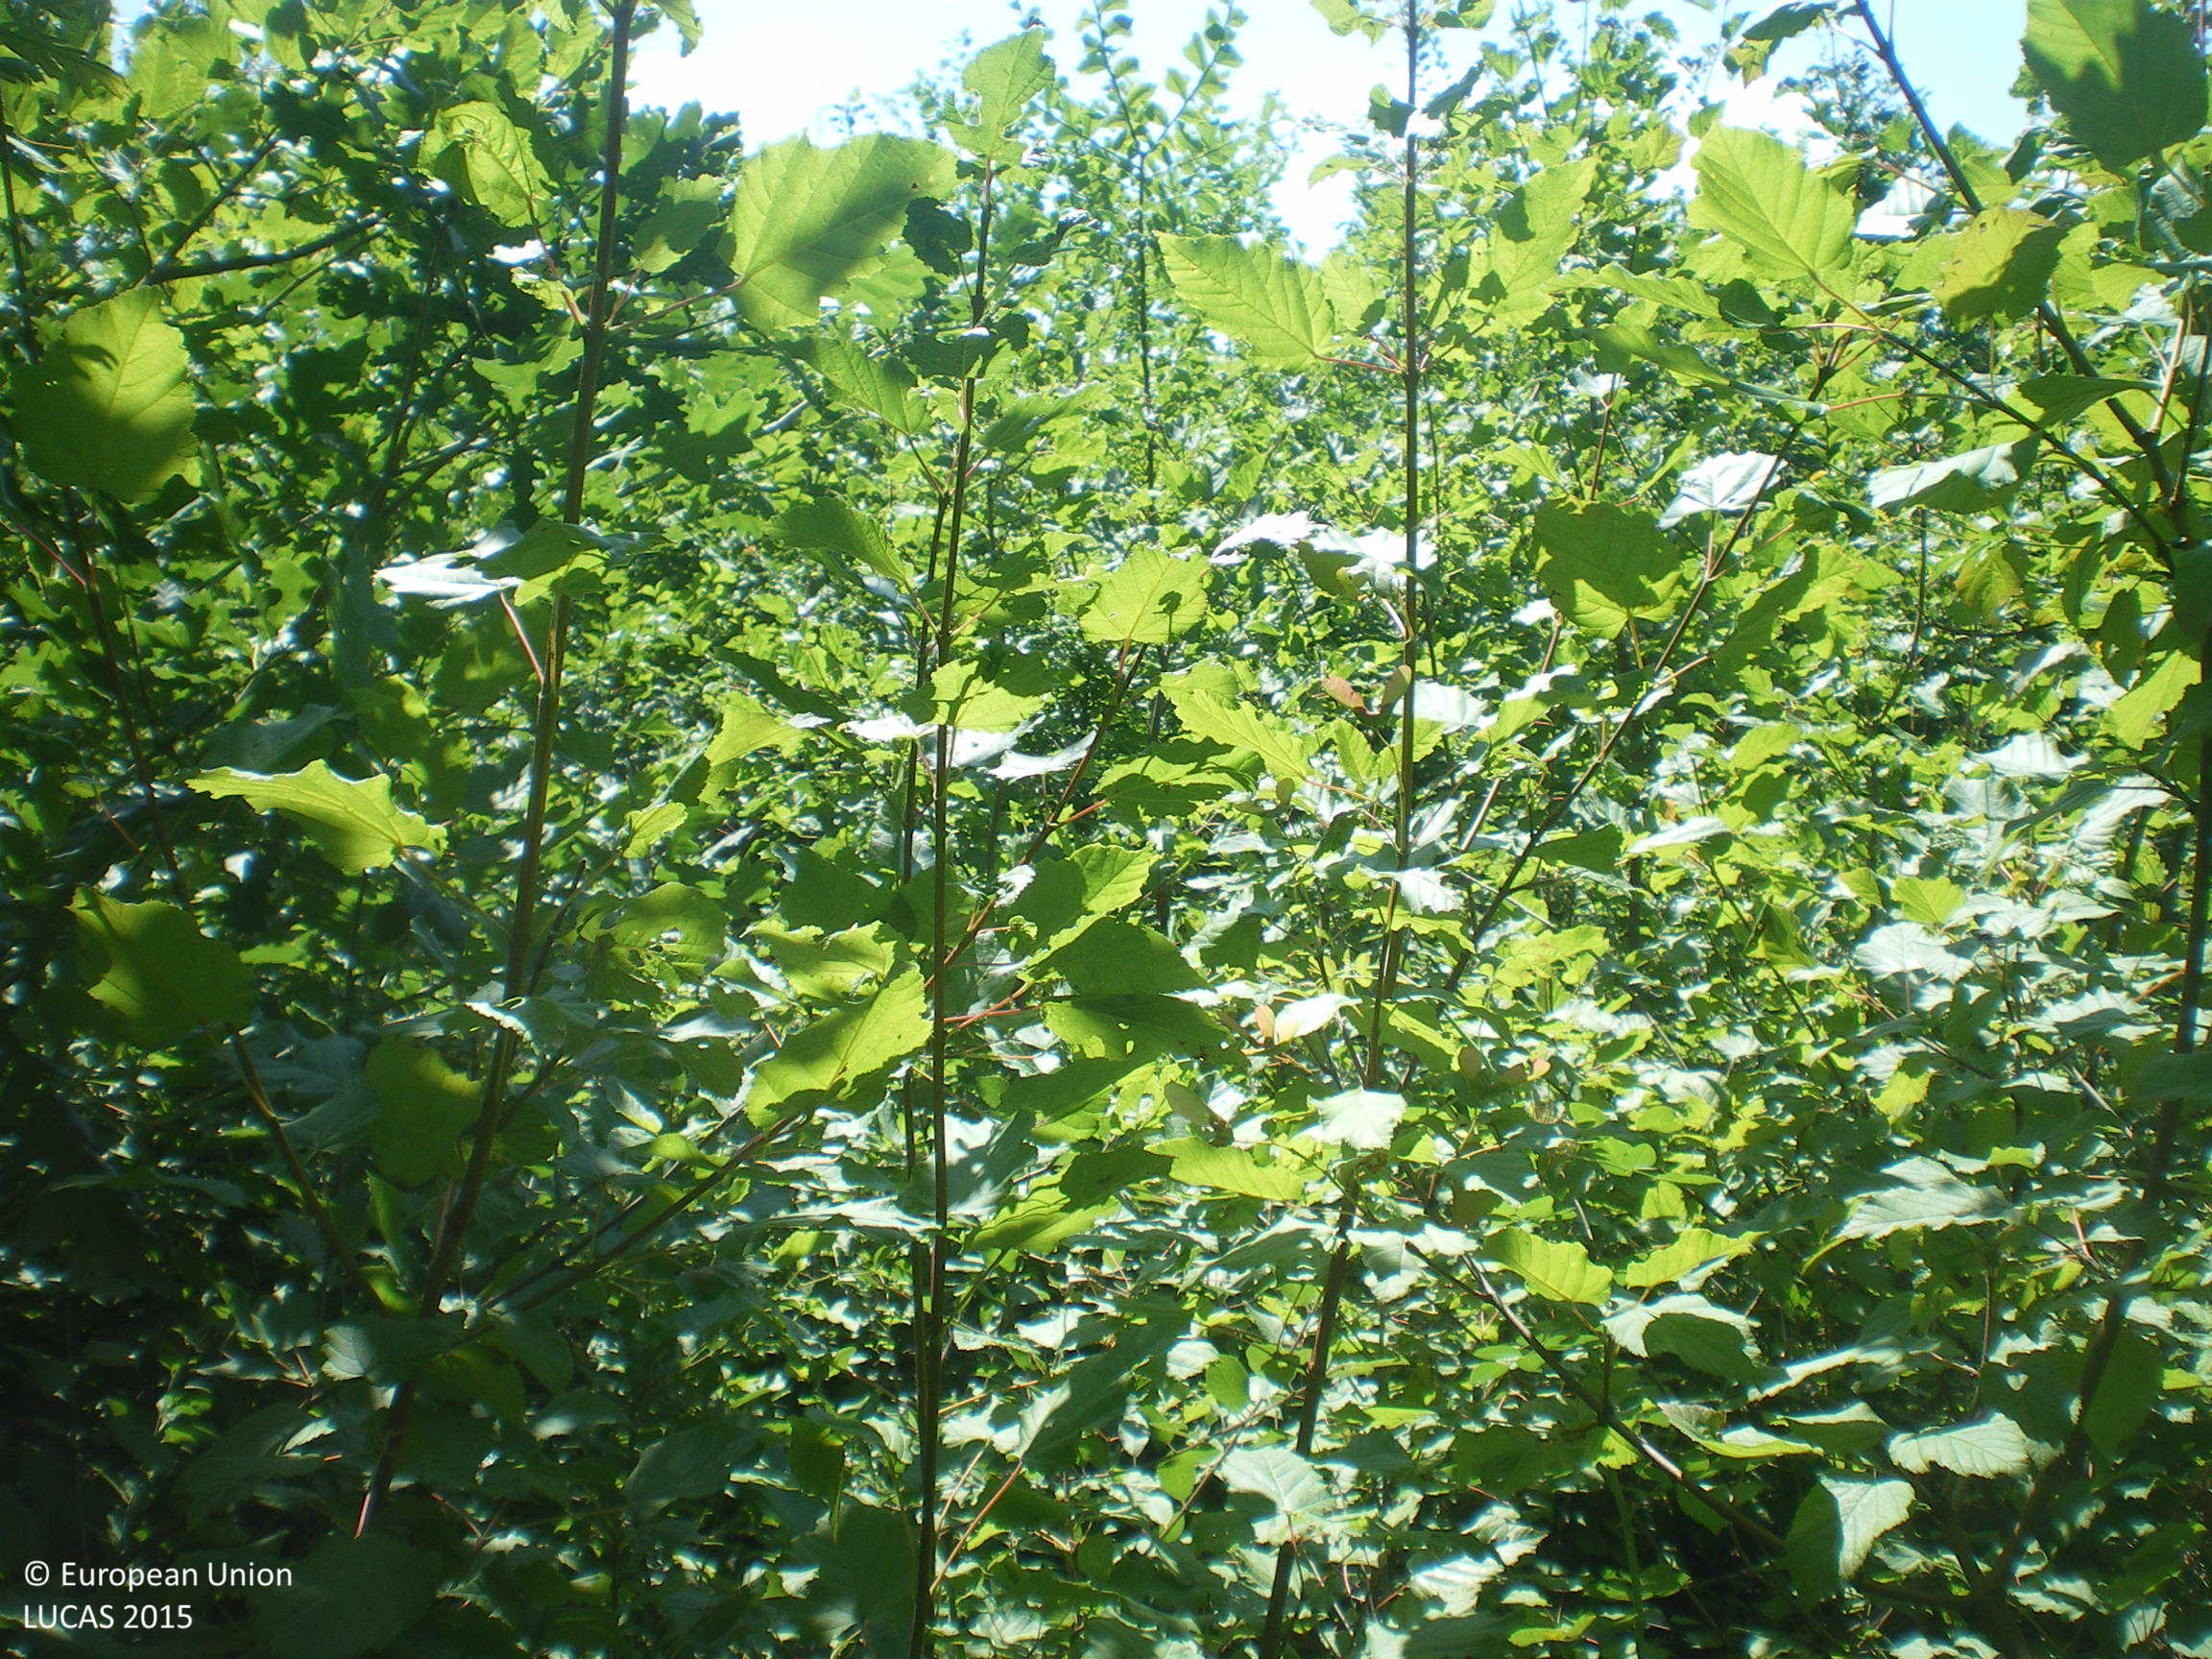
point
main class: Woodland
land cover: Broadleaved woodland
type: mesophytic deciduous forest
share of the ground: > 75 %
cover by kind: broadleaved forest trees 95 %, shrubs 5 %
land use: Forestry
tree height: > 5 m
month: July
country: BG
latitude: 42.4054
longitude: 25.8597
